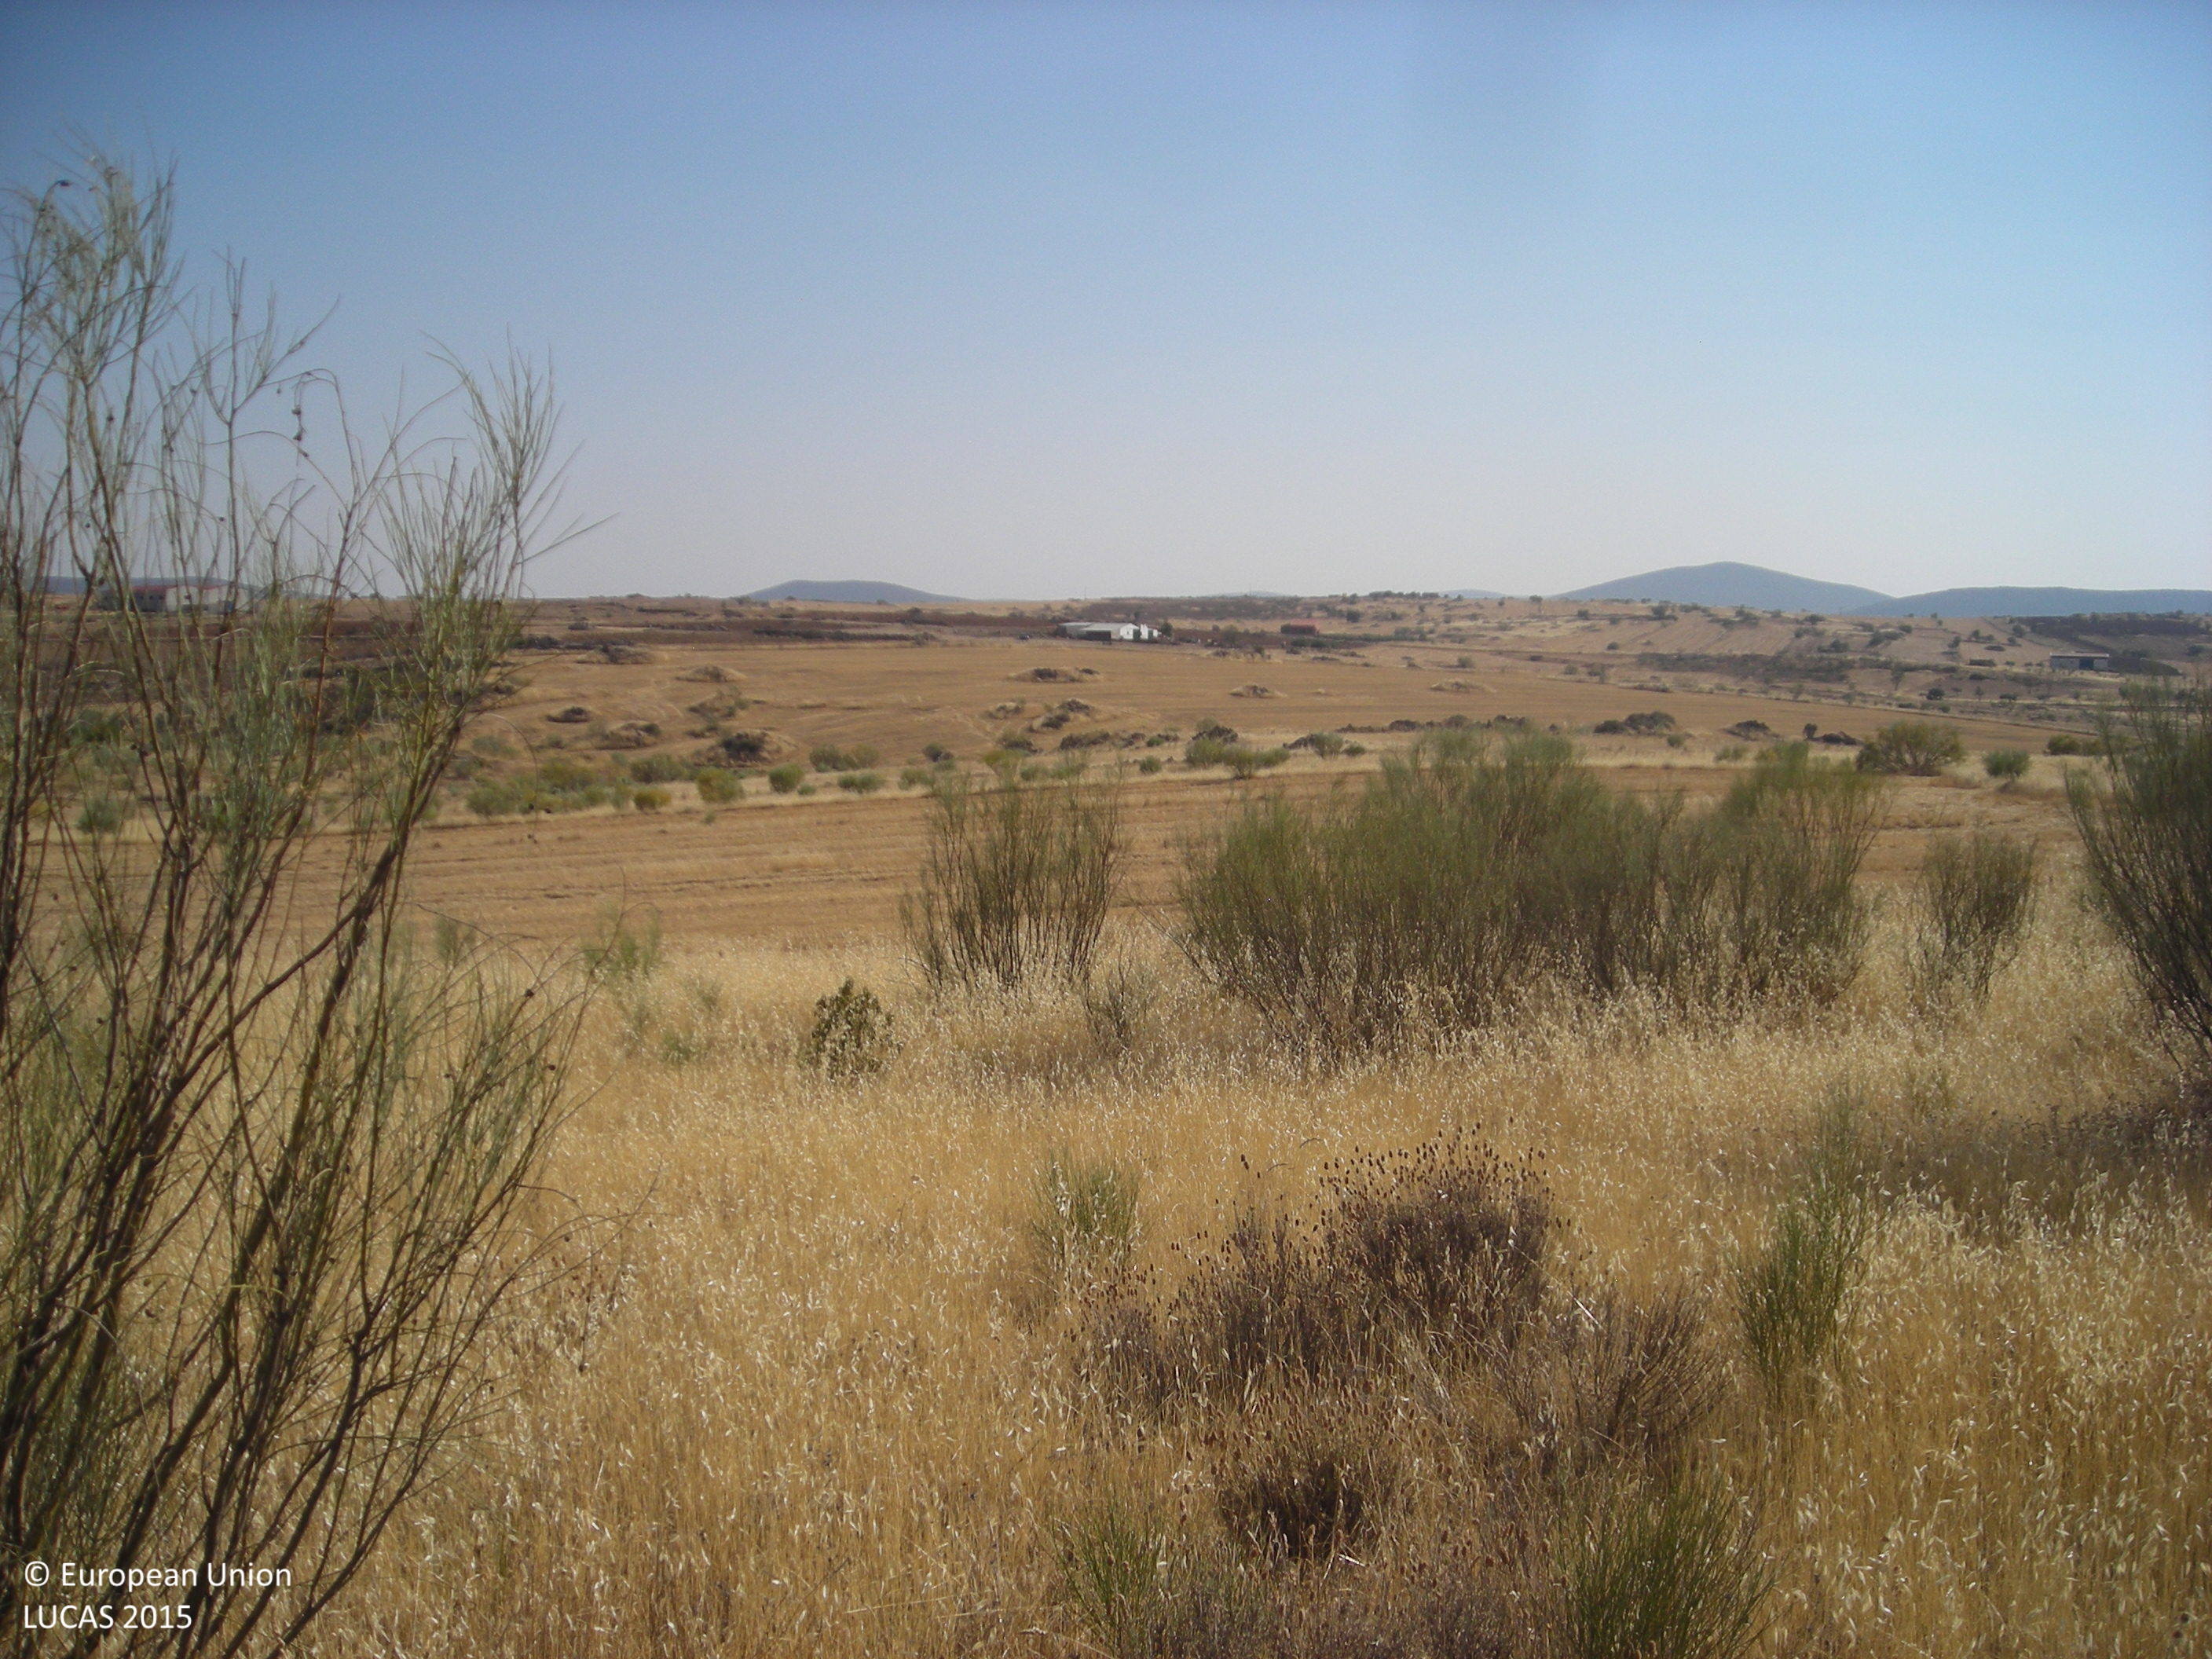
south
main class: Shrubland
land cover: Shrubland without tree cover
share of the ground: > 75 %
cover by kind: shrubs 100 %
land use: Agriculture (excluding fallow land and kitchen gardens)
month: July
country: ES
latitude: 38.6903
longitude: -5.7590
